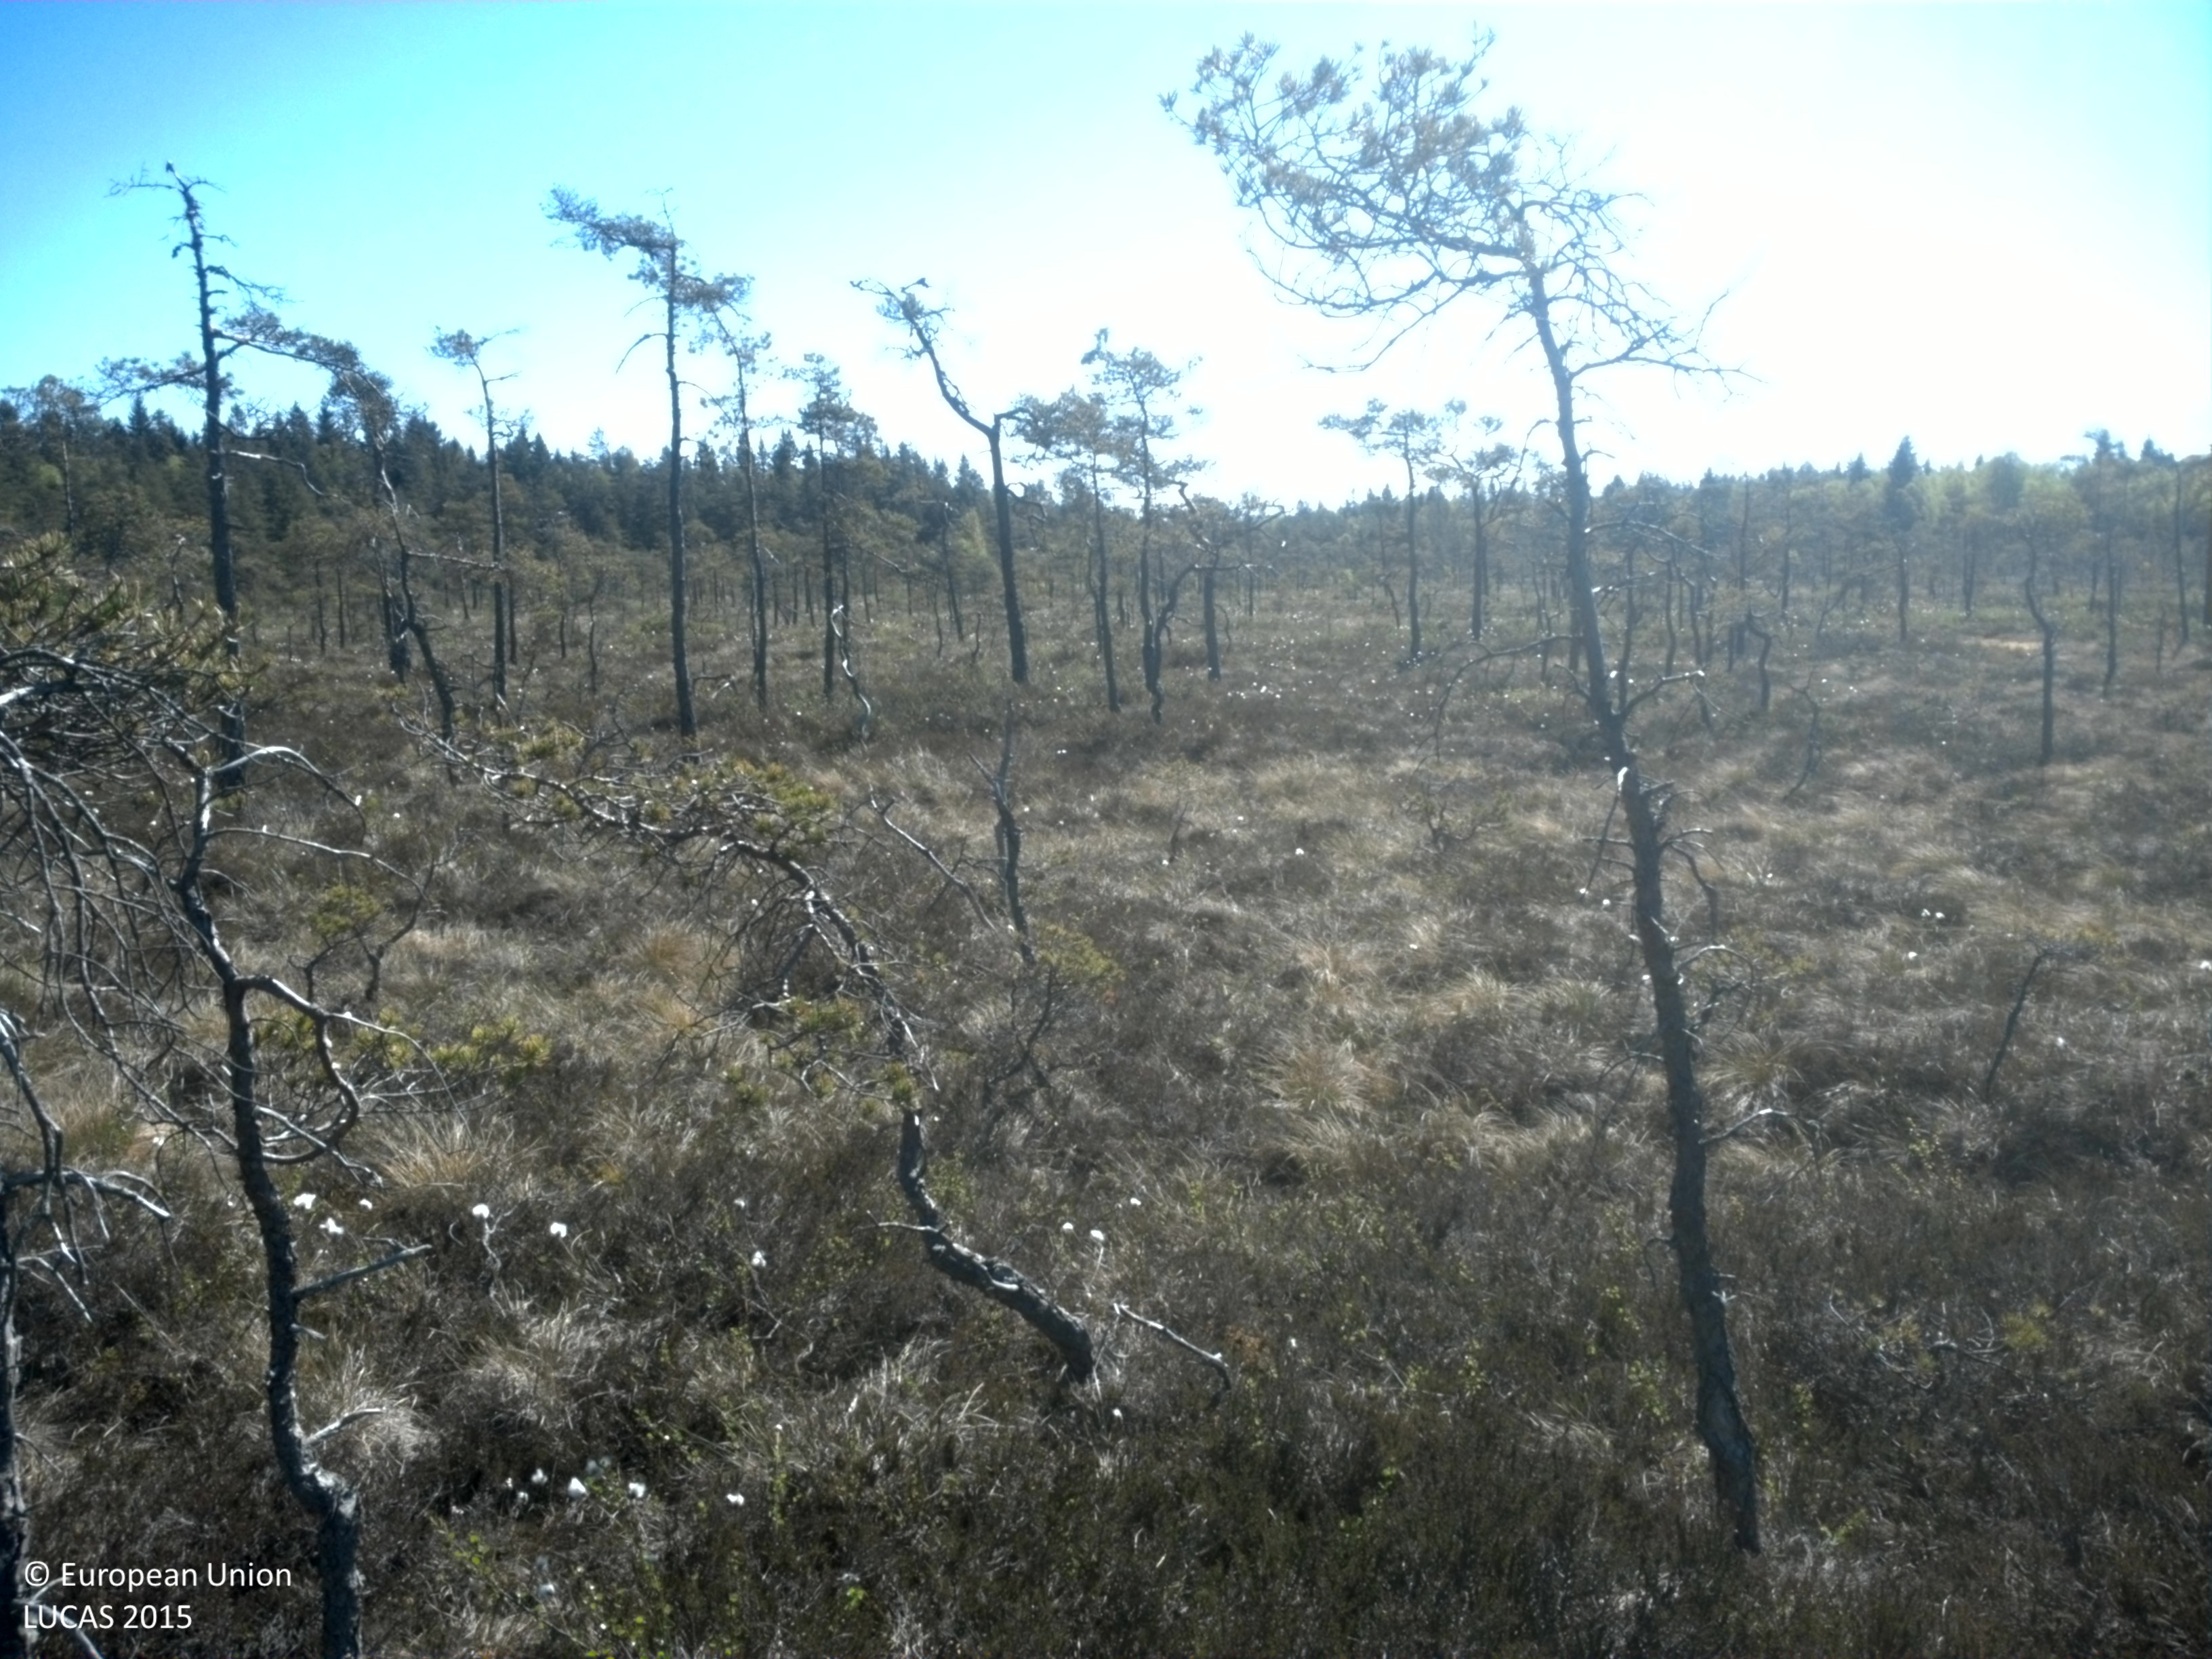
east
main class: Woodland
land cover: Pine dominated coniferous woodland
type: mire and swamp forests
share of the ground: 10 - 25 %
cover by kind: shrubs 40 %, herbaceous plants 35 %, coniferous forest trees 15 %, lichens and mosses 10 %
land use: Semi-natural and natural areas not in use
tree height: < 5 m
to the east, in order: Pine dominated coniferous woodland; Peatbogs
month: June
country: SE
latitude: 59.4182
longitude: 14.0973
